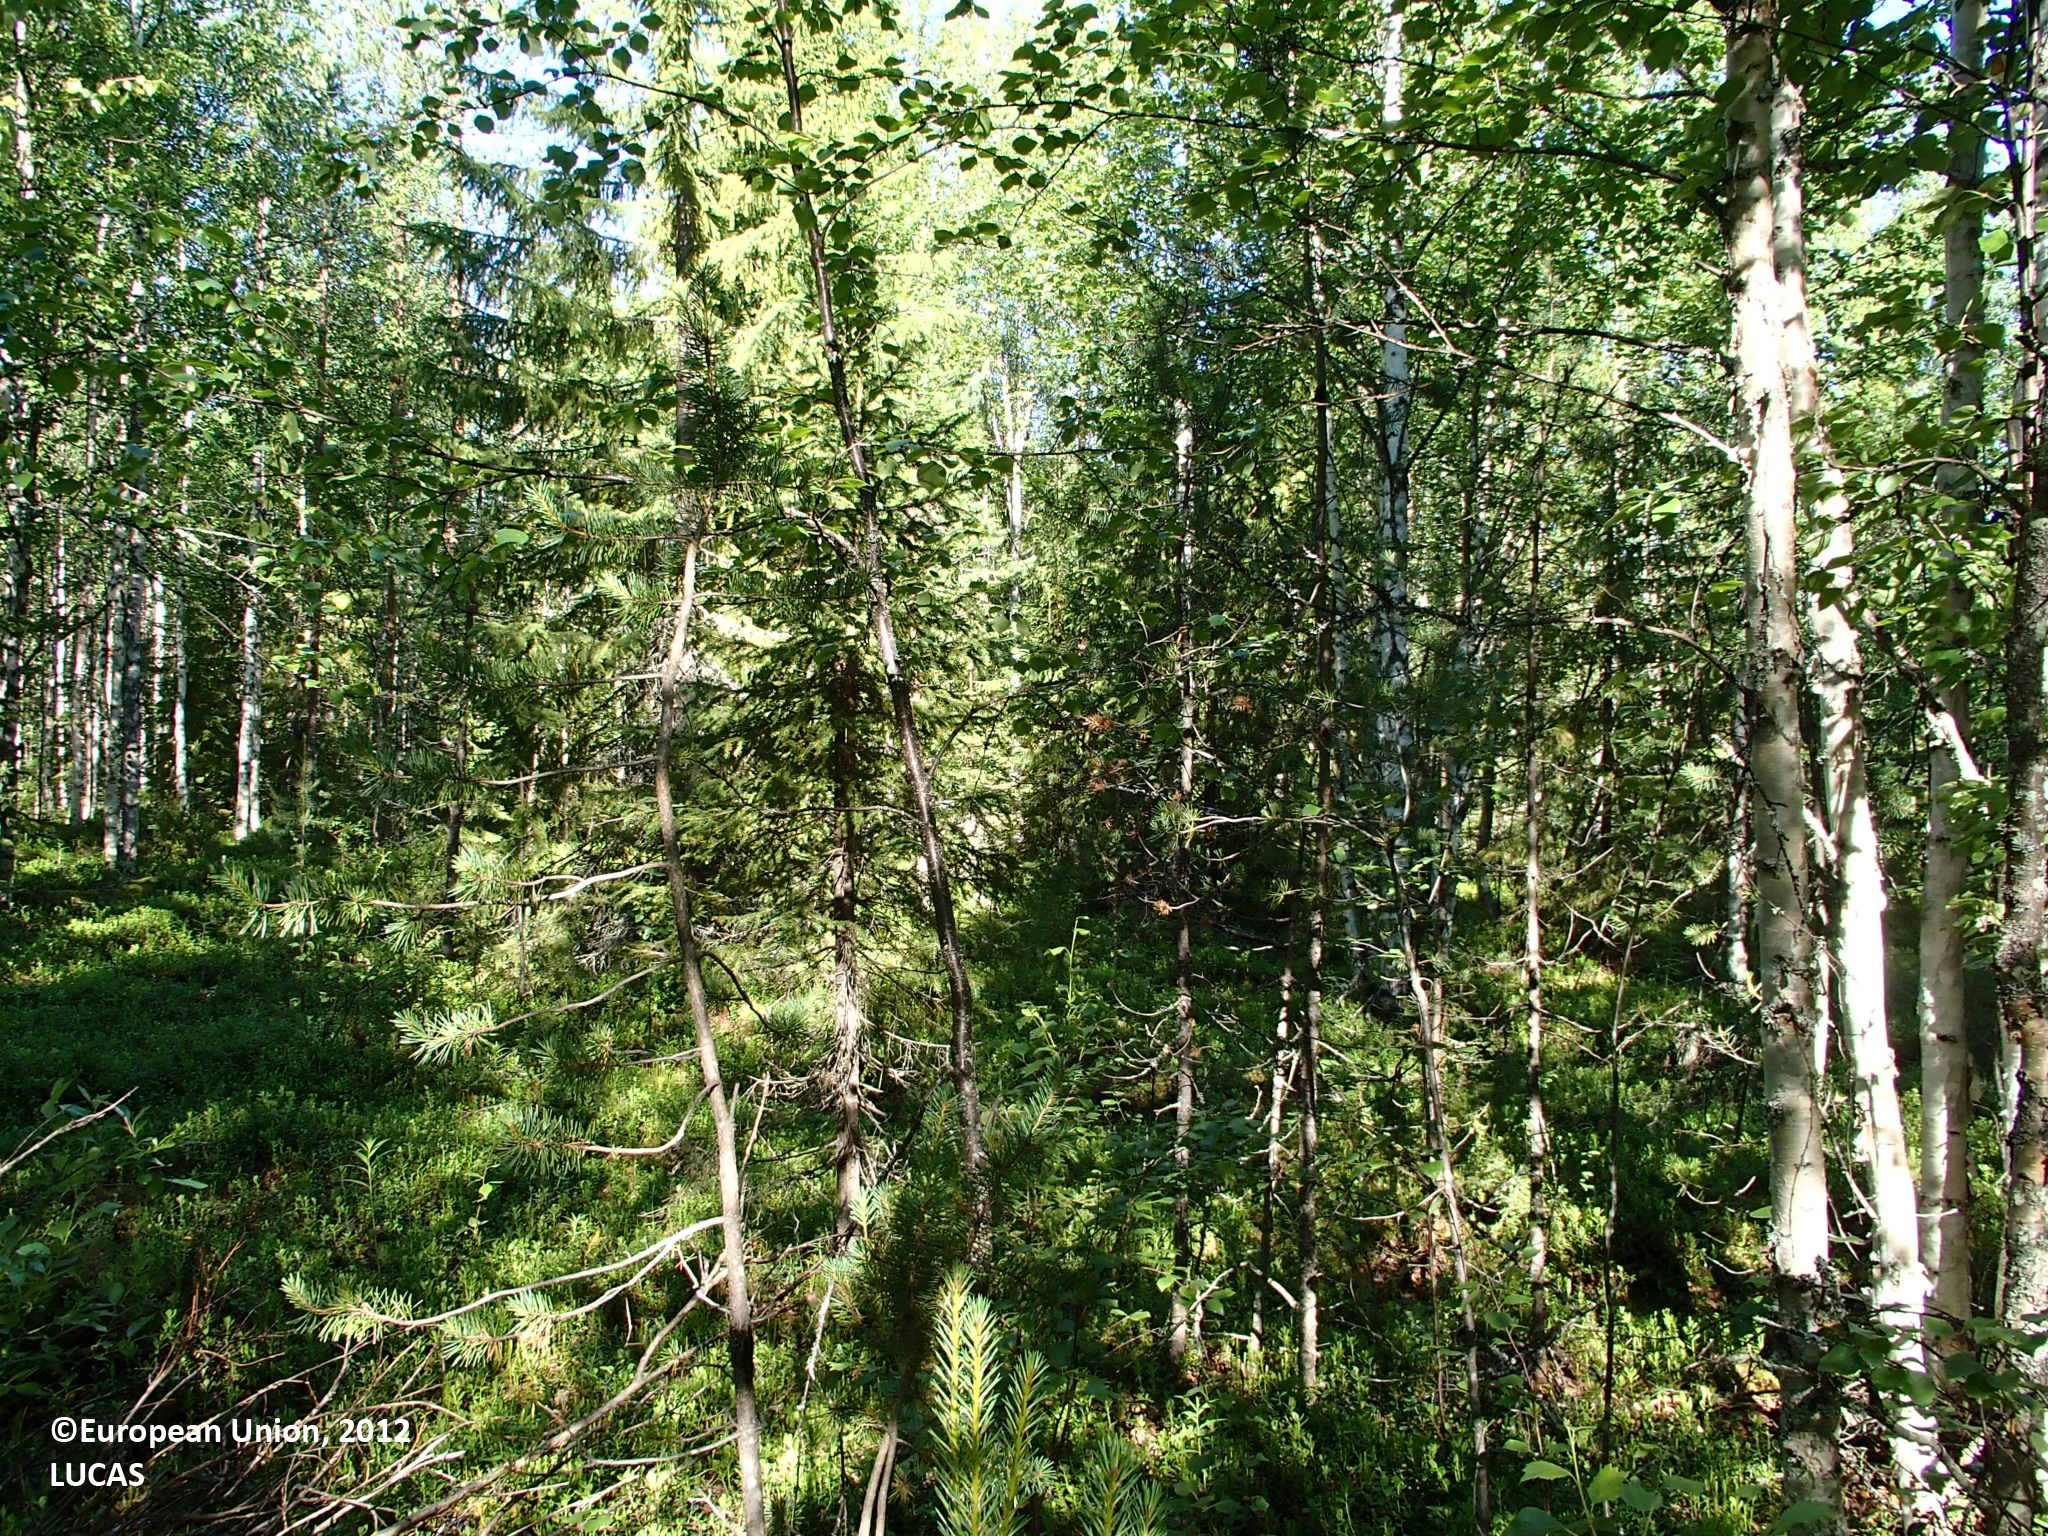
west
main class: Woodland
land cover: Other mixed woodland
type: boreal forest
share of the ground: > 75 %
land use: Forestry
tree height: > 5 m
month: July
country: FI
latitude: 66.8564
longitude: 25.4478
